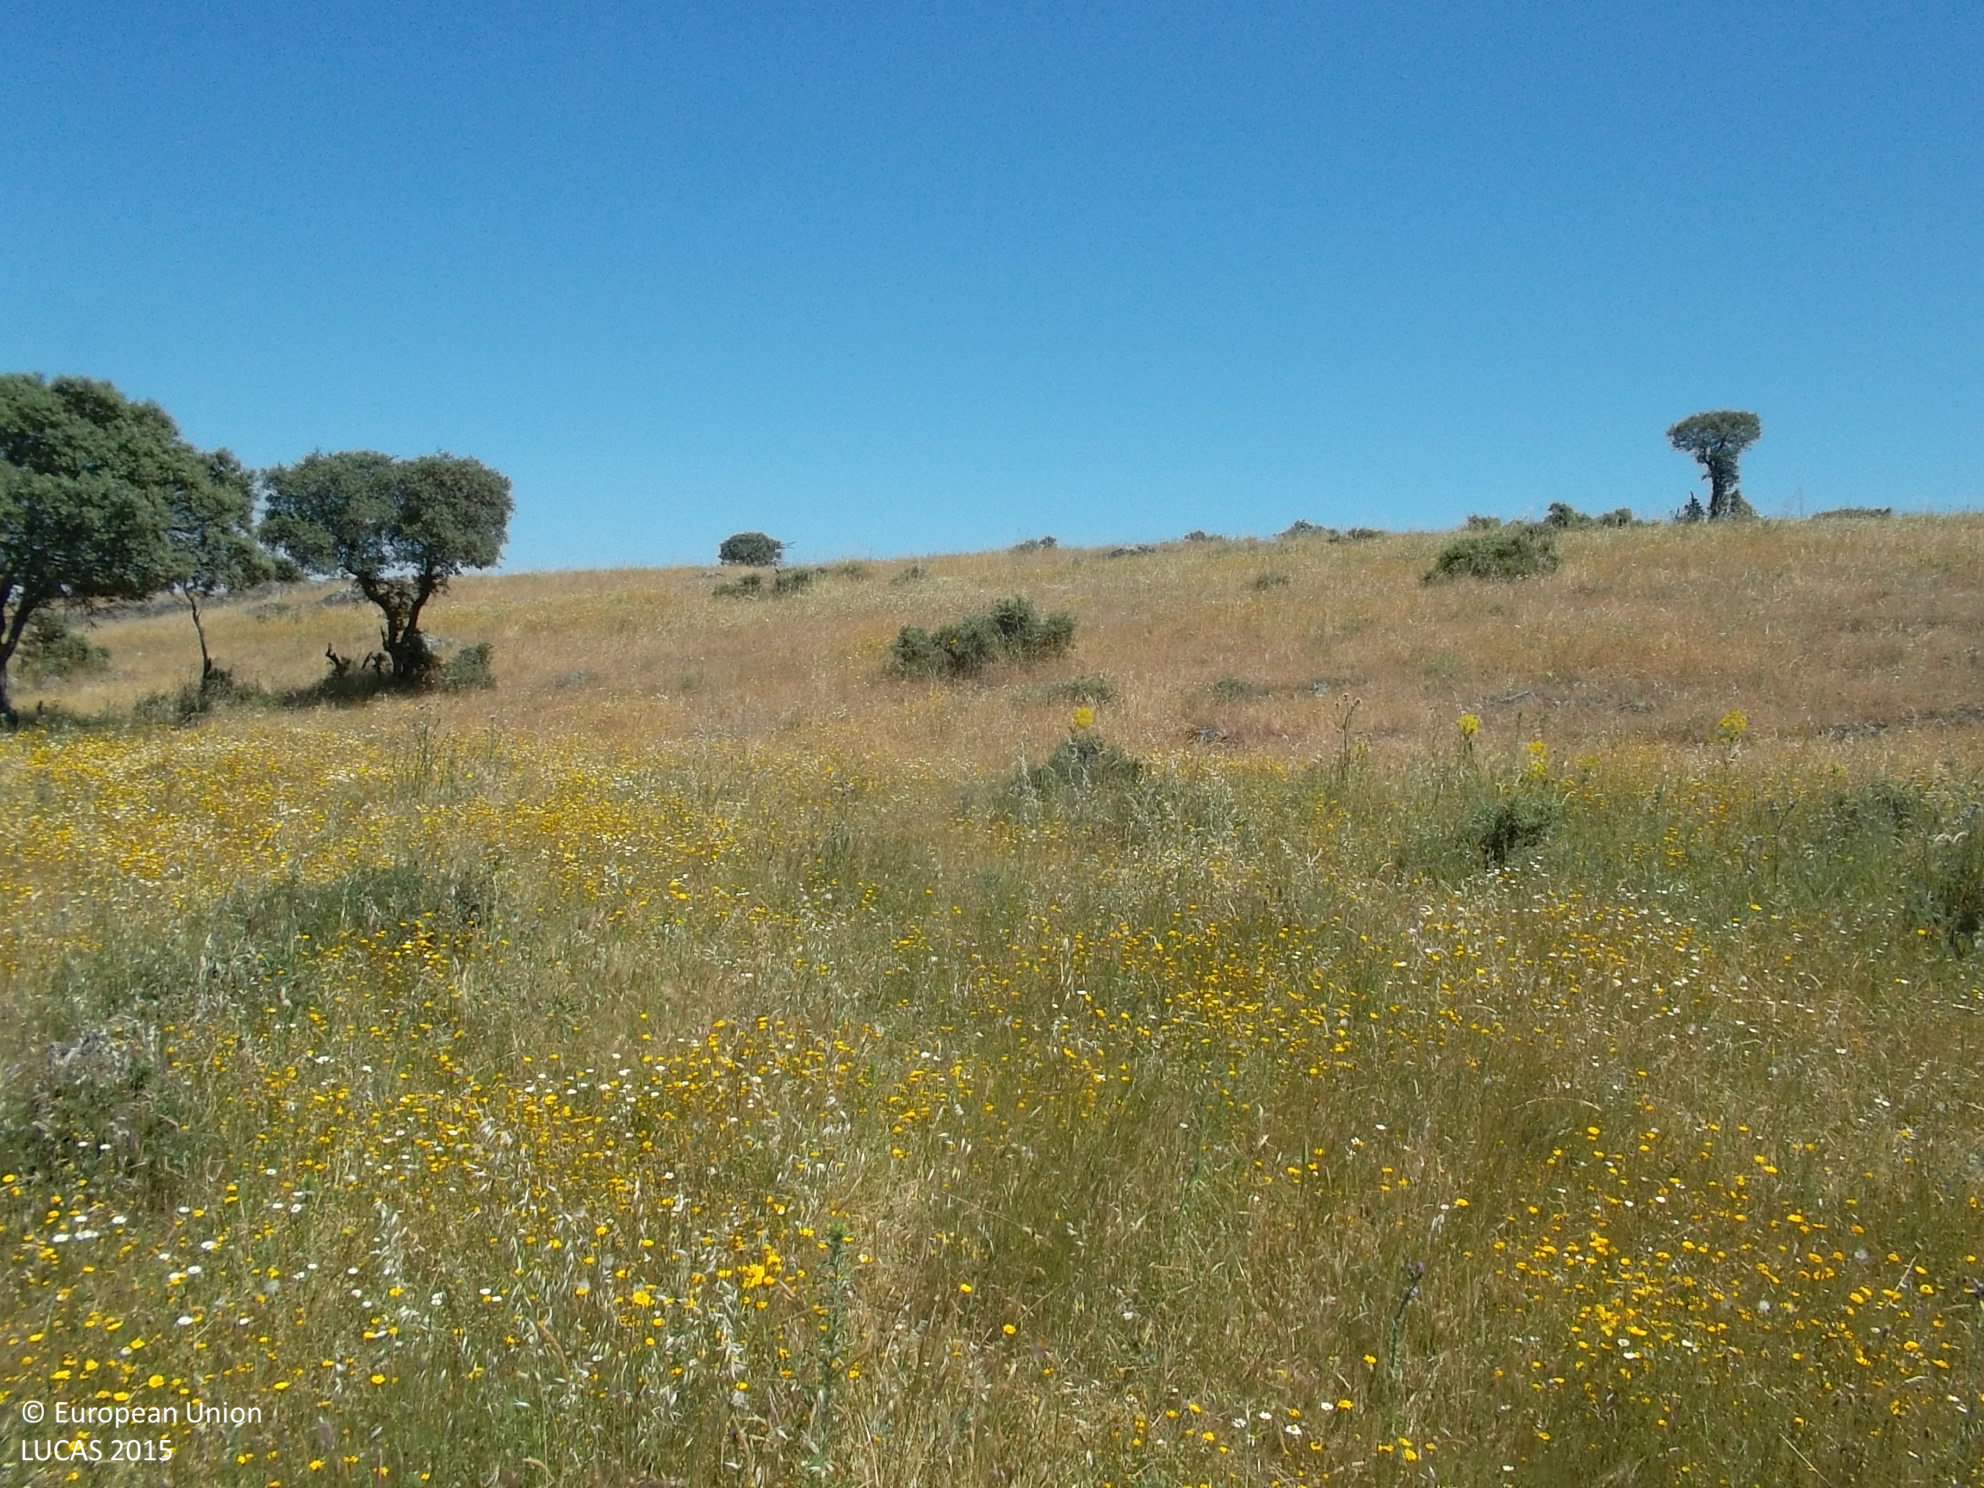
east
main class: Grassland
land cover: Grassland with sparse tree/shrub cover
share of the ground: > 75 %
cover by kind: herbaceous plants 95 %, broadleaved forest trees 5 %
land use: Agriculture (excluding fallow land and kitchen gardens)
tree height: > 5 m
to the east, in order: Grassland with sparse tree/shrub cover; Rock outcrops; Grassland without tree/shrub cover; Fences; Spontaneously vegetated surfaces; Fences; Grassland with sparse tree/shrub cover
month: May
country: ES
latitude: 38.8621
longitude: -4.4423
